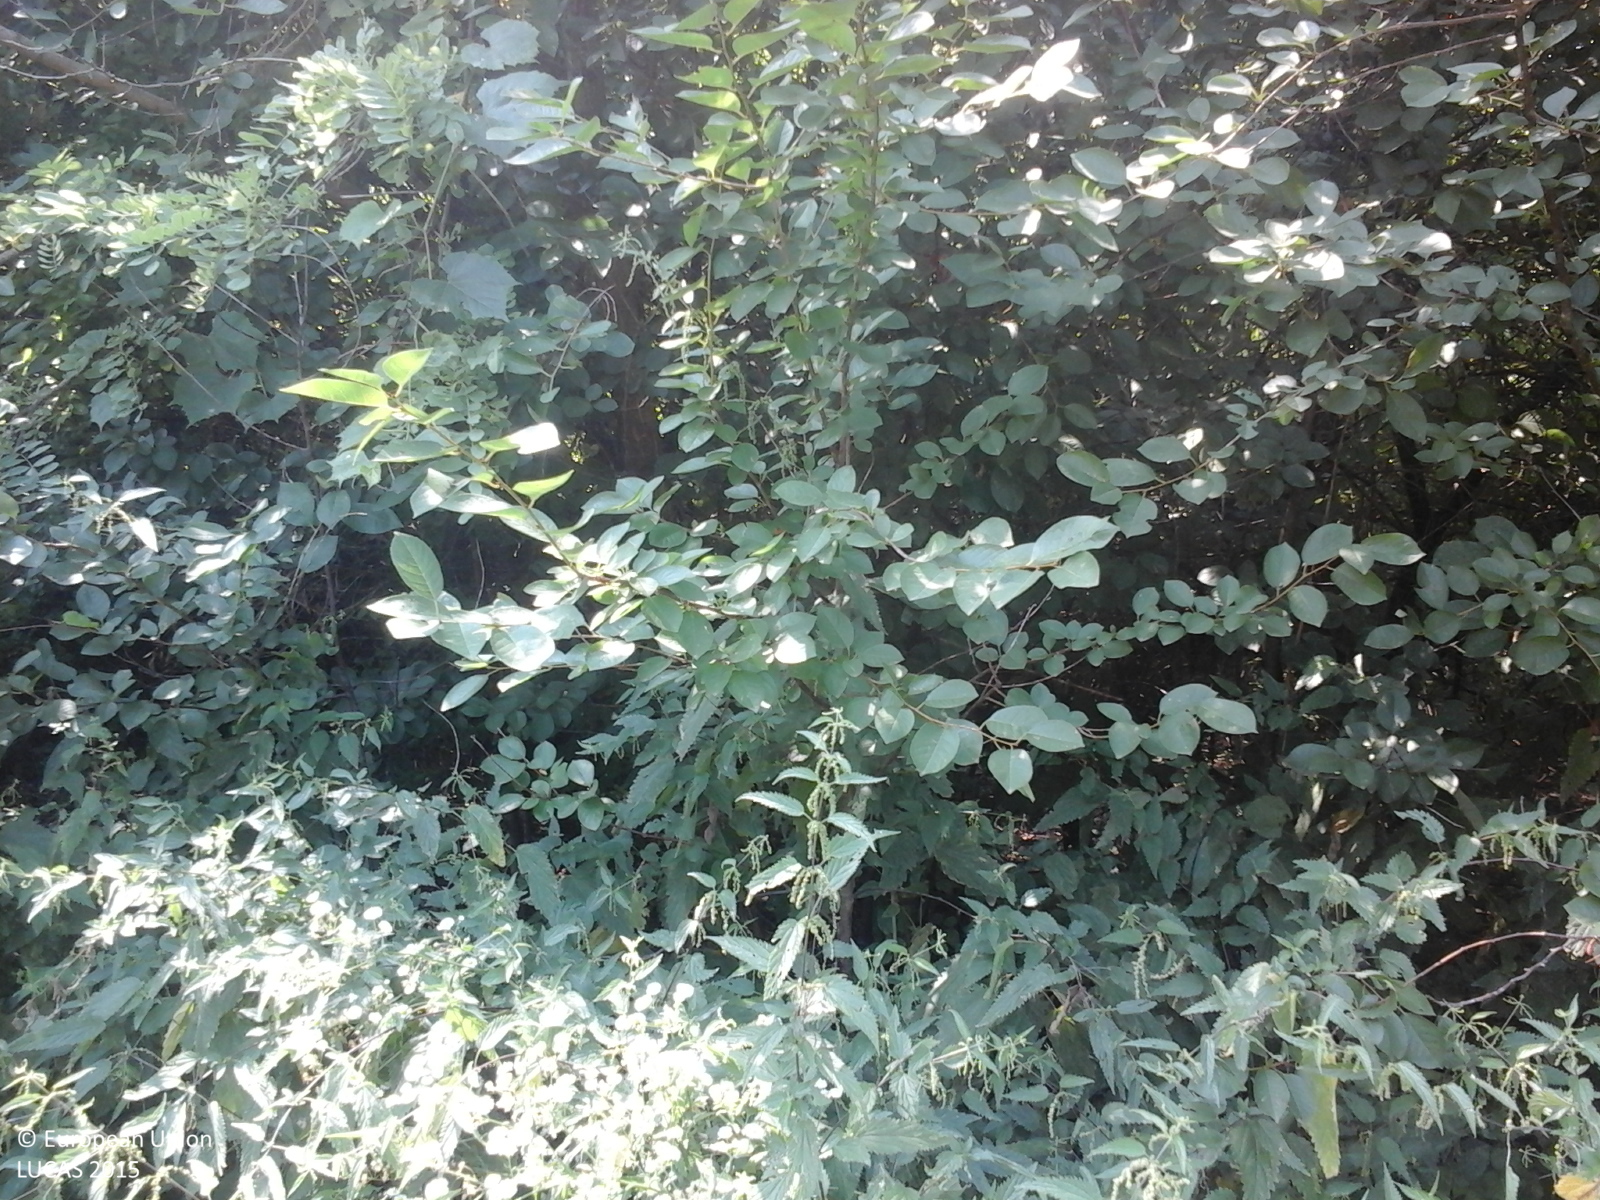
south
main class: Grassland
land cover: Spontaneously vegetated surfaces
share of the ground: > 75 %
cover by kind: herbaceous plants 100 %
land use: Fallow land
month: July
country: RO
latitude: 44.5980
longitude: 26.5070
